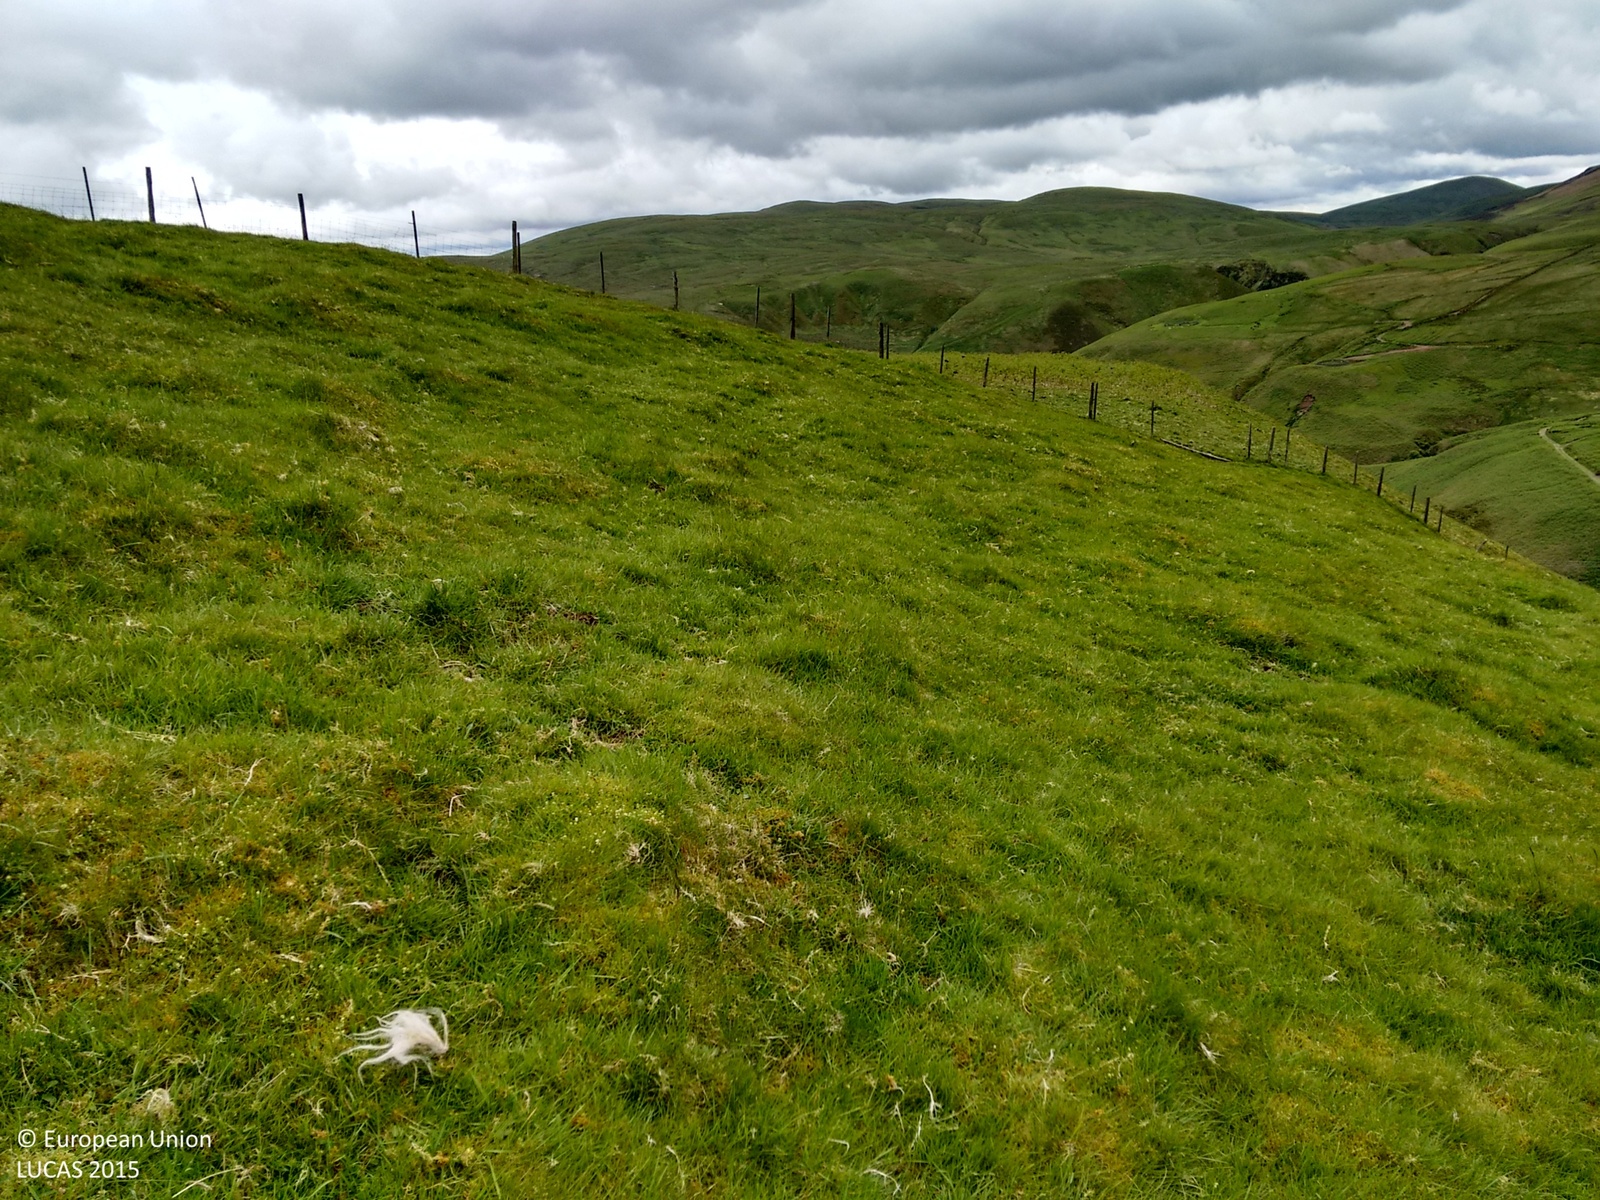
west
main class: Grassland
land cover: Grassland without tree/shrub cover
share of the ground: > 75 %
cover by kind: herbaceous plants 100 %
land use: Agriculture (excluding fallow land and kitchen gardens)
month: June
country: GB
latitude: 55.3505
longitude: -3.7581
